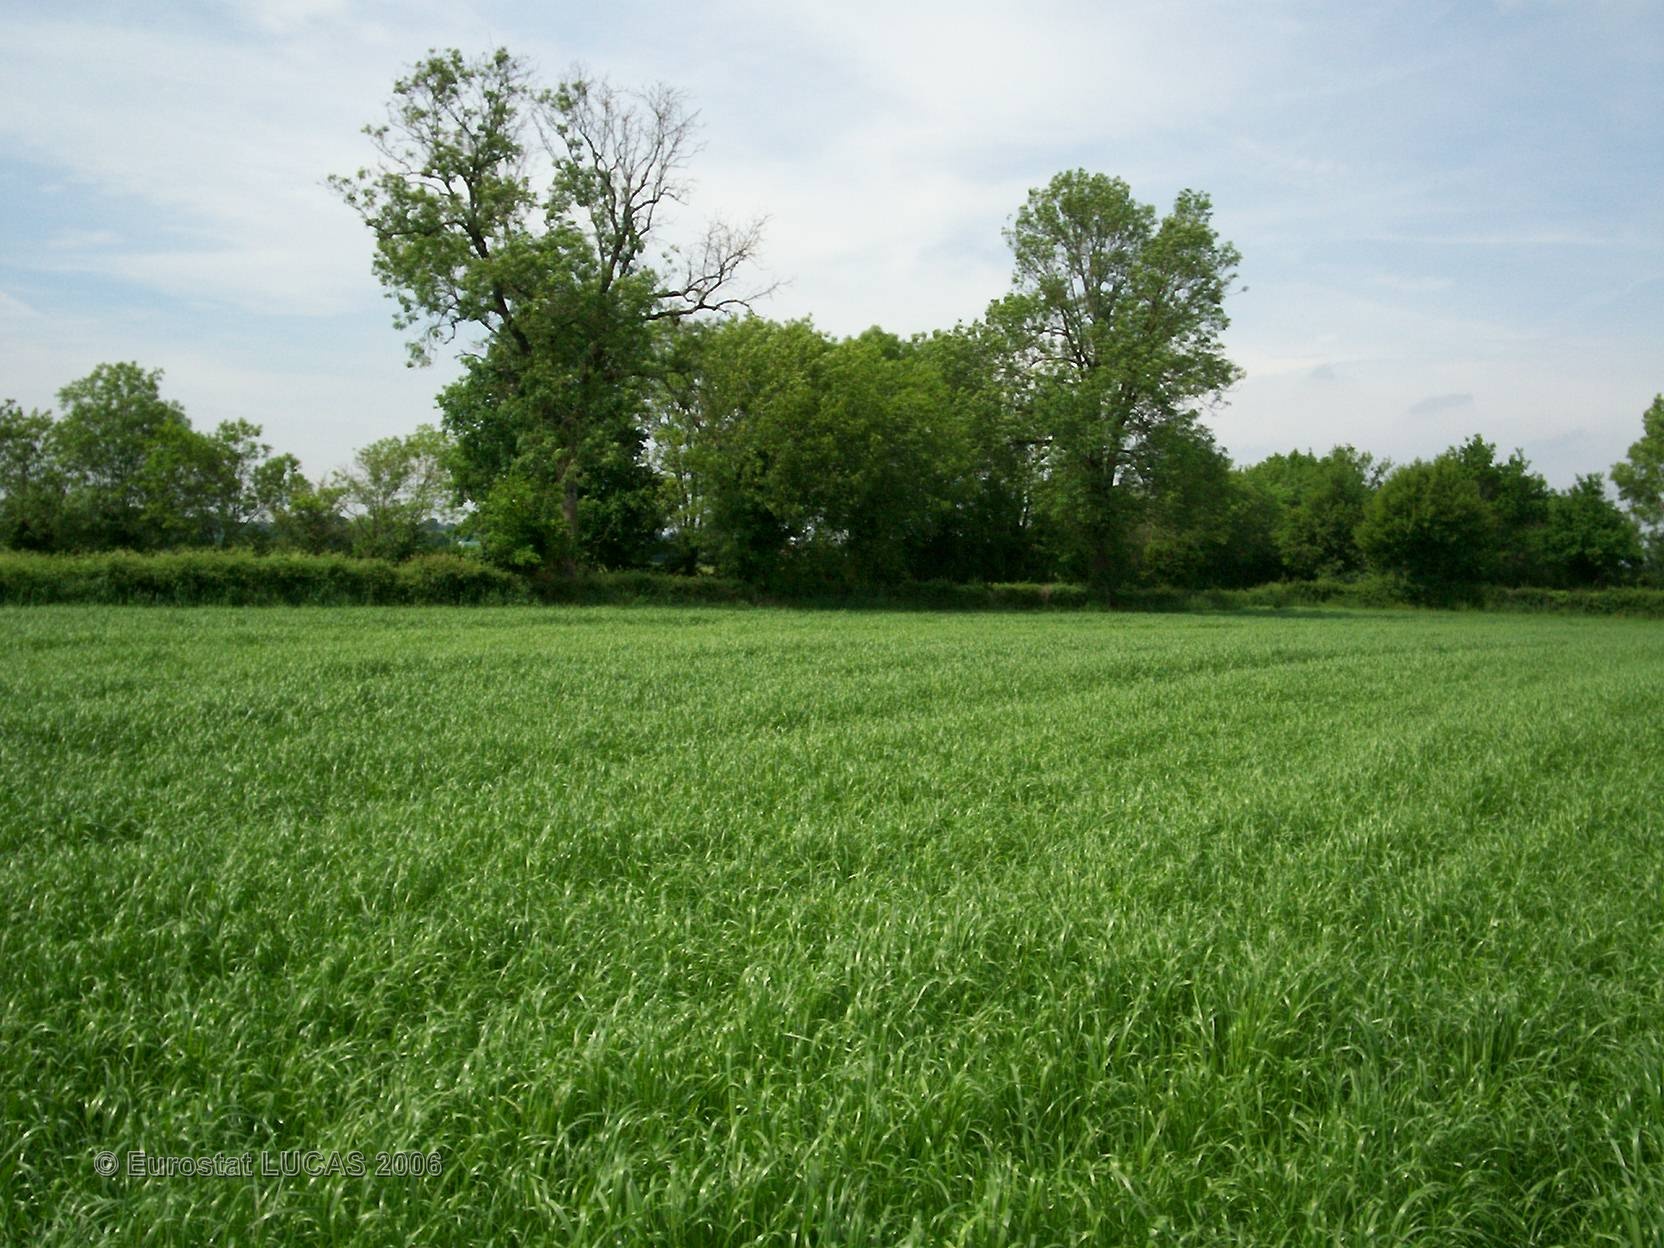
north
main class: Grassland
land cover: Grassland without tree/shrub cover
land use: Agriculture (excluding fallow land and kitchen gardens)
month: May
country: FR
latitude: 46.4520
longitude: -0.2961
